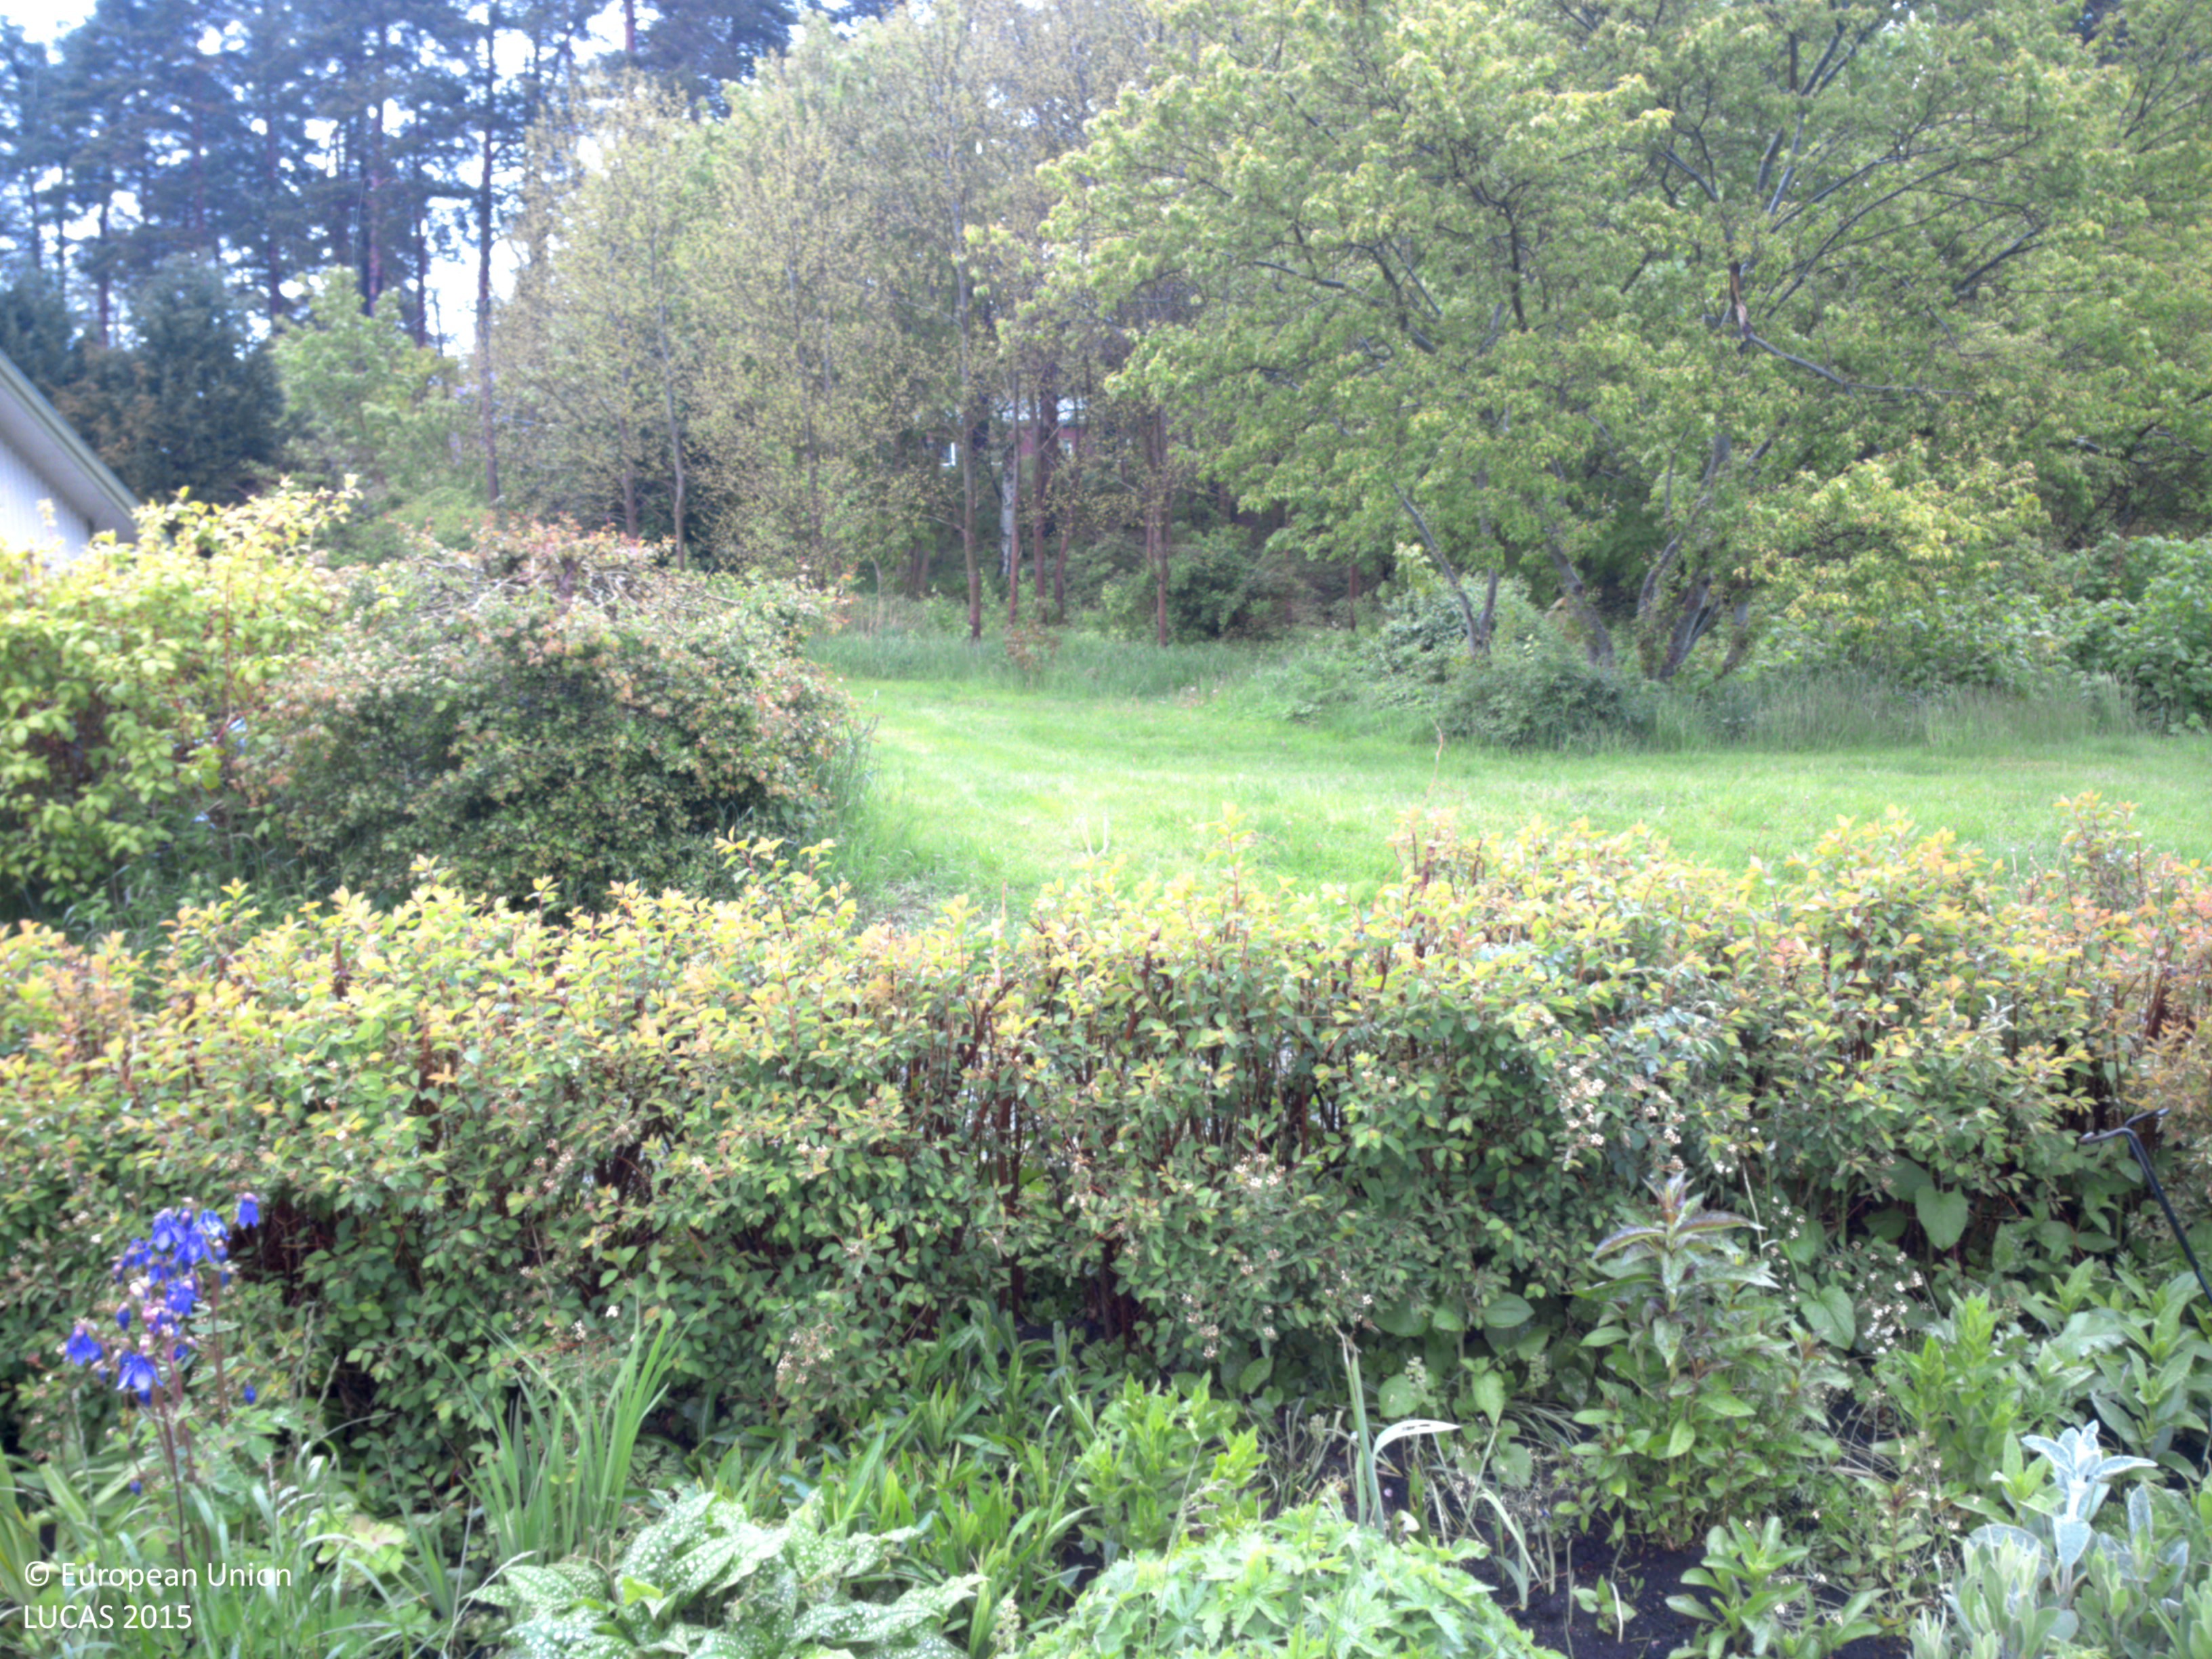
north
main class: Grassland
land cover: Grassland without tree/shrub cover
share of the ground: > 75 %
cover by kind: herbaceous plants 100 %
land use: Residential
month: June
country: SE
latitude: 57.8399
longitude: 12.3038
